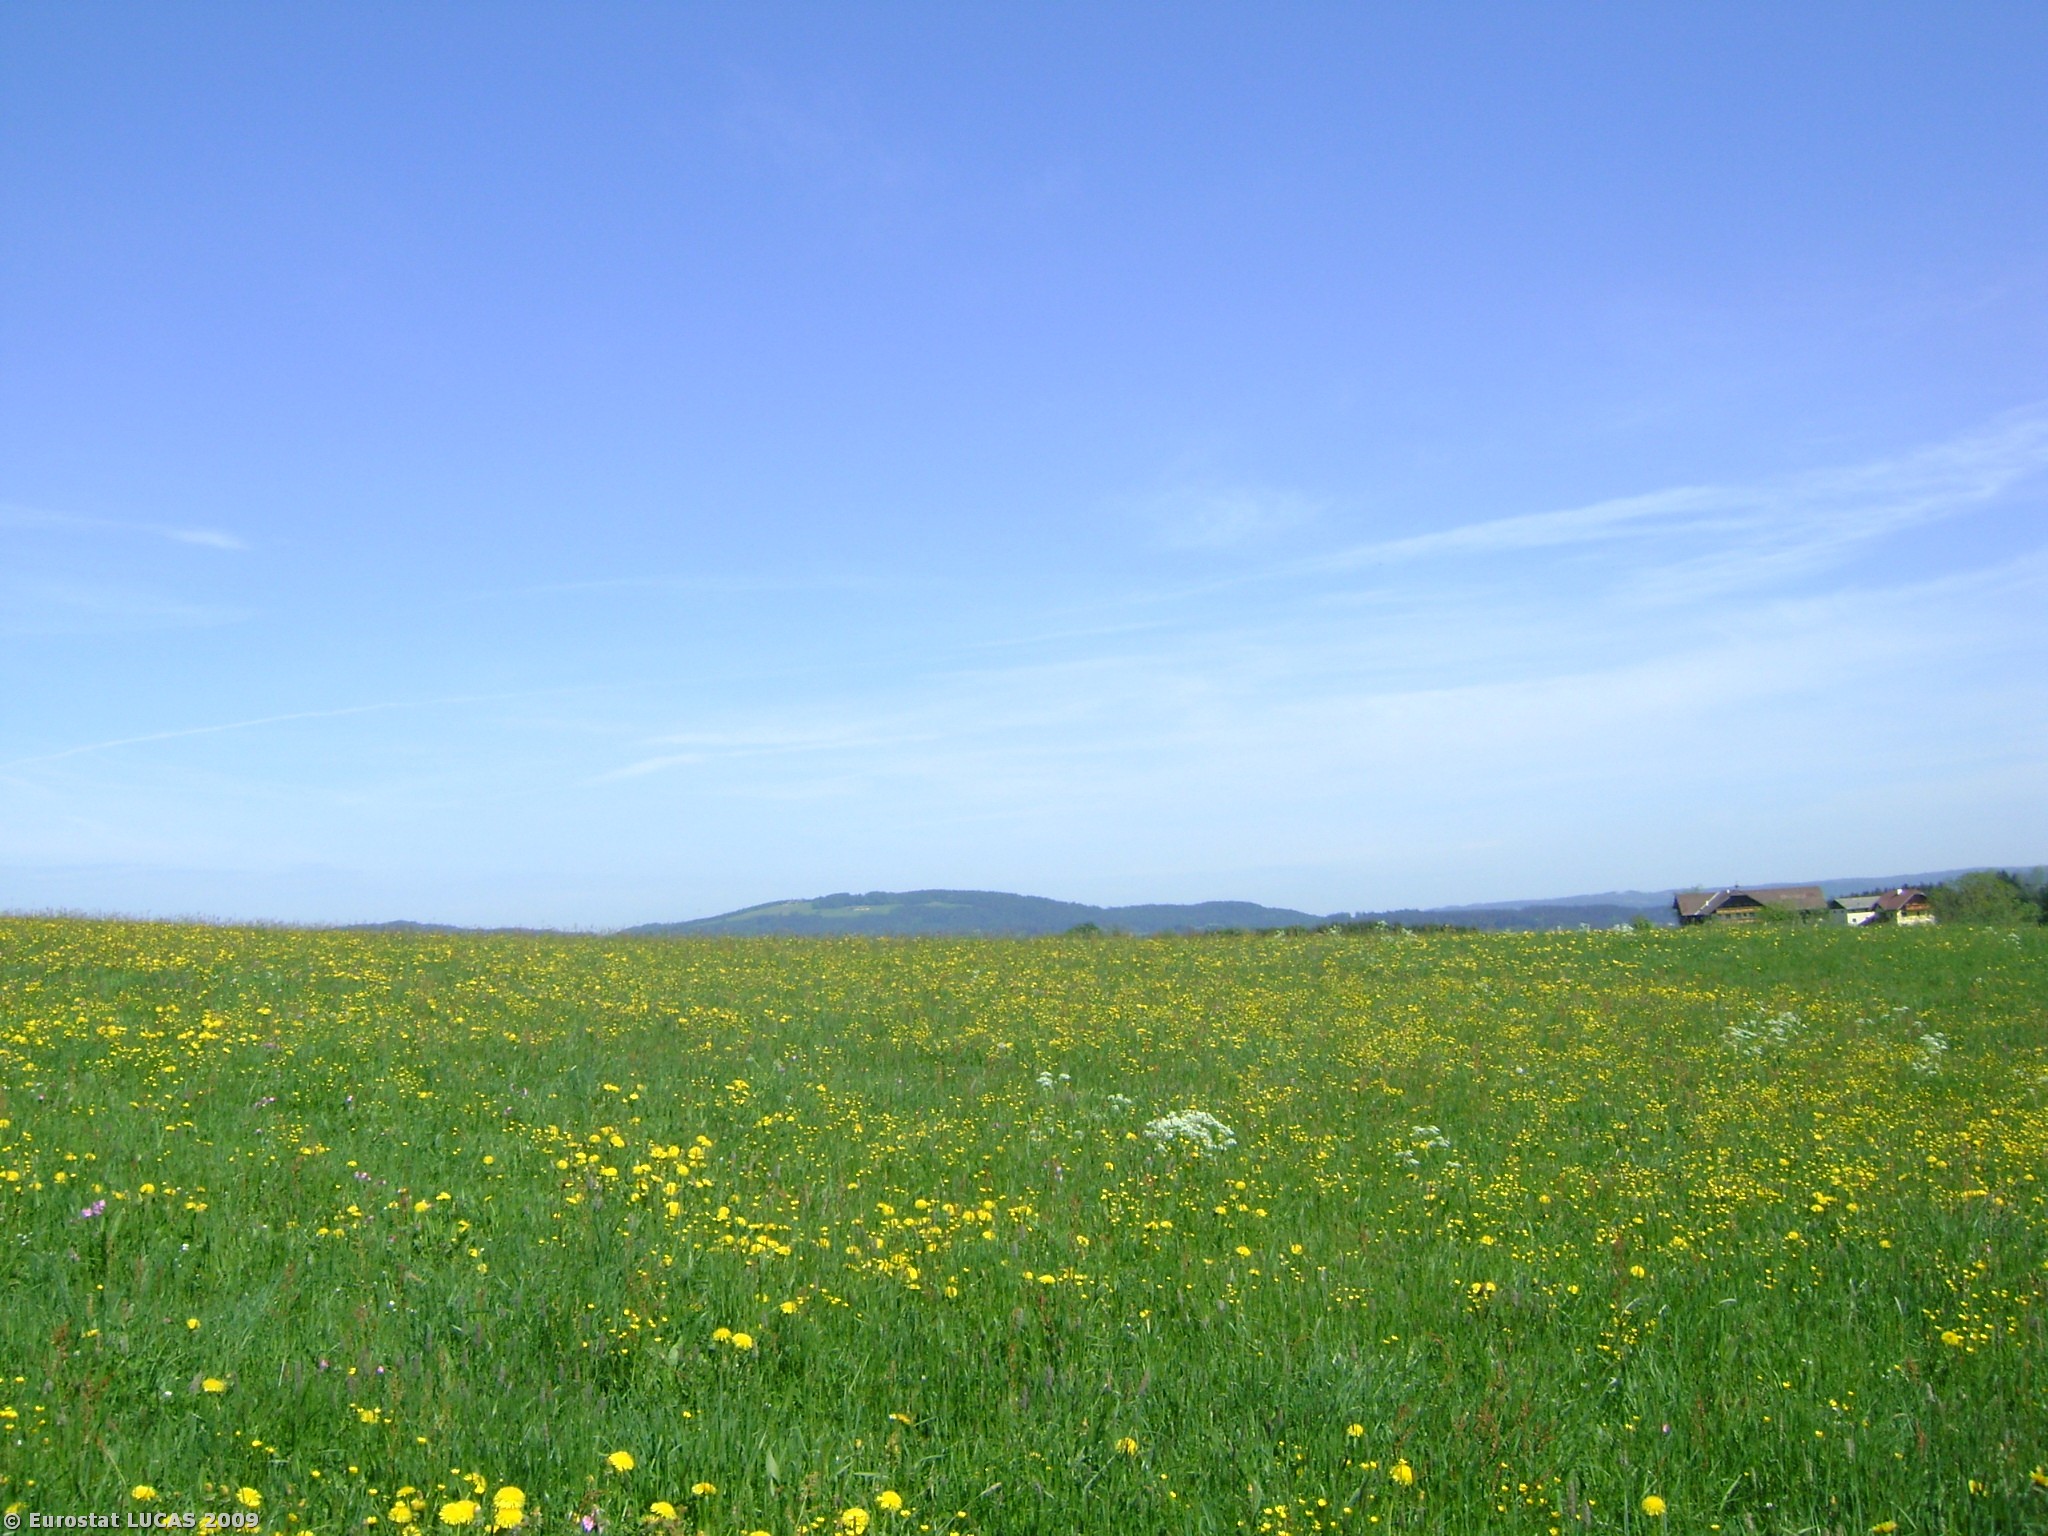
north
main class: Grassland
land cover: Grassland without tree/shrub cover
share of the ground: > 75 %
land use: Agriculture (excluding fallow land and kitchen gardens)
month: May
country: AT
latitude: 47.9063
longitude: 13.2230
